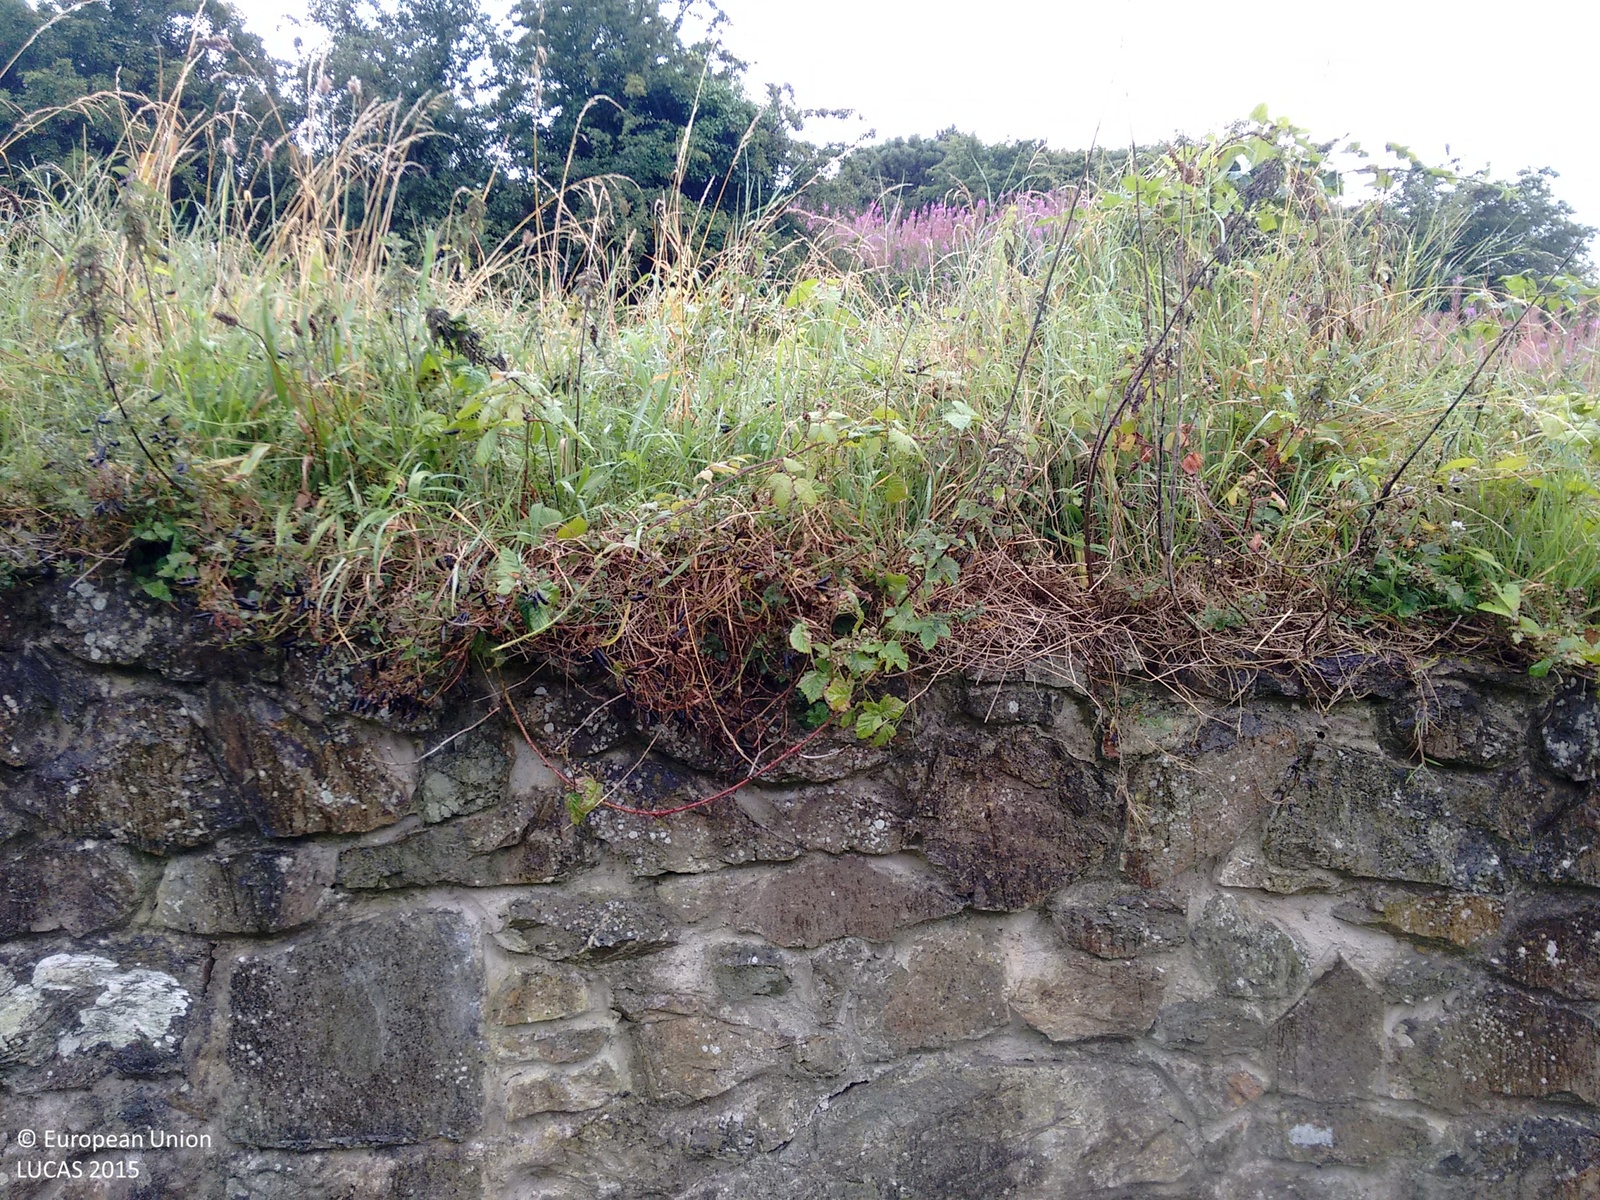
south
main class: Grassland
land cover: Grassland without tree/shrub cover
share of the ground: > 75 %
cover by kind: herbaceous plants 100 %
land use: Semi-natural and natural areas not in use
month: August
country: GB
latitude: 54.3299
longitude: -5.7108
